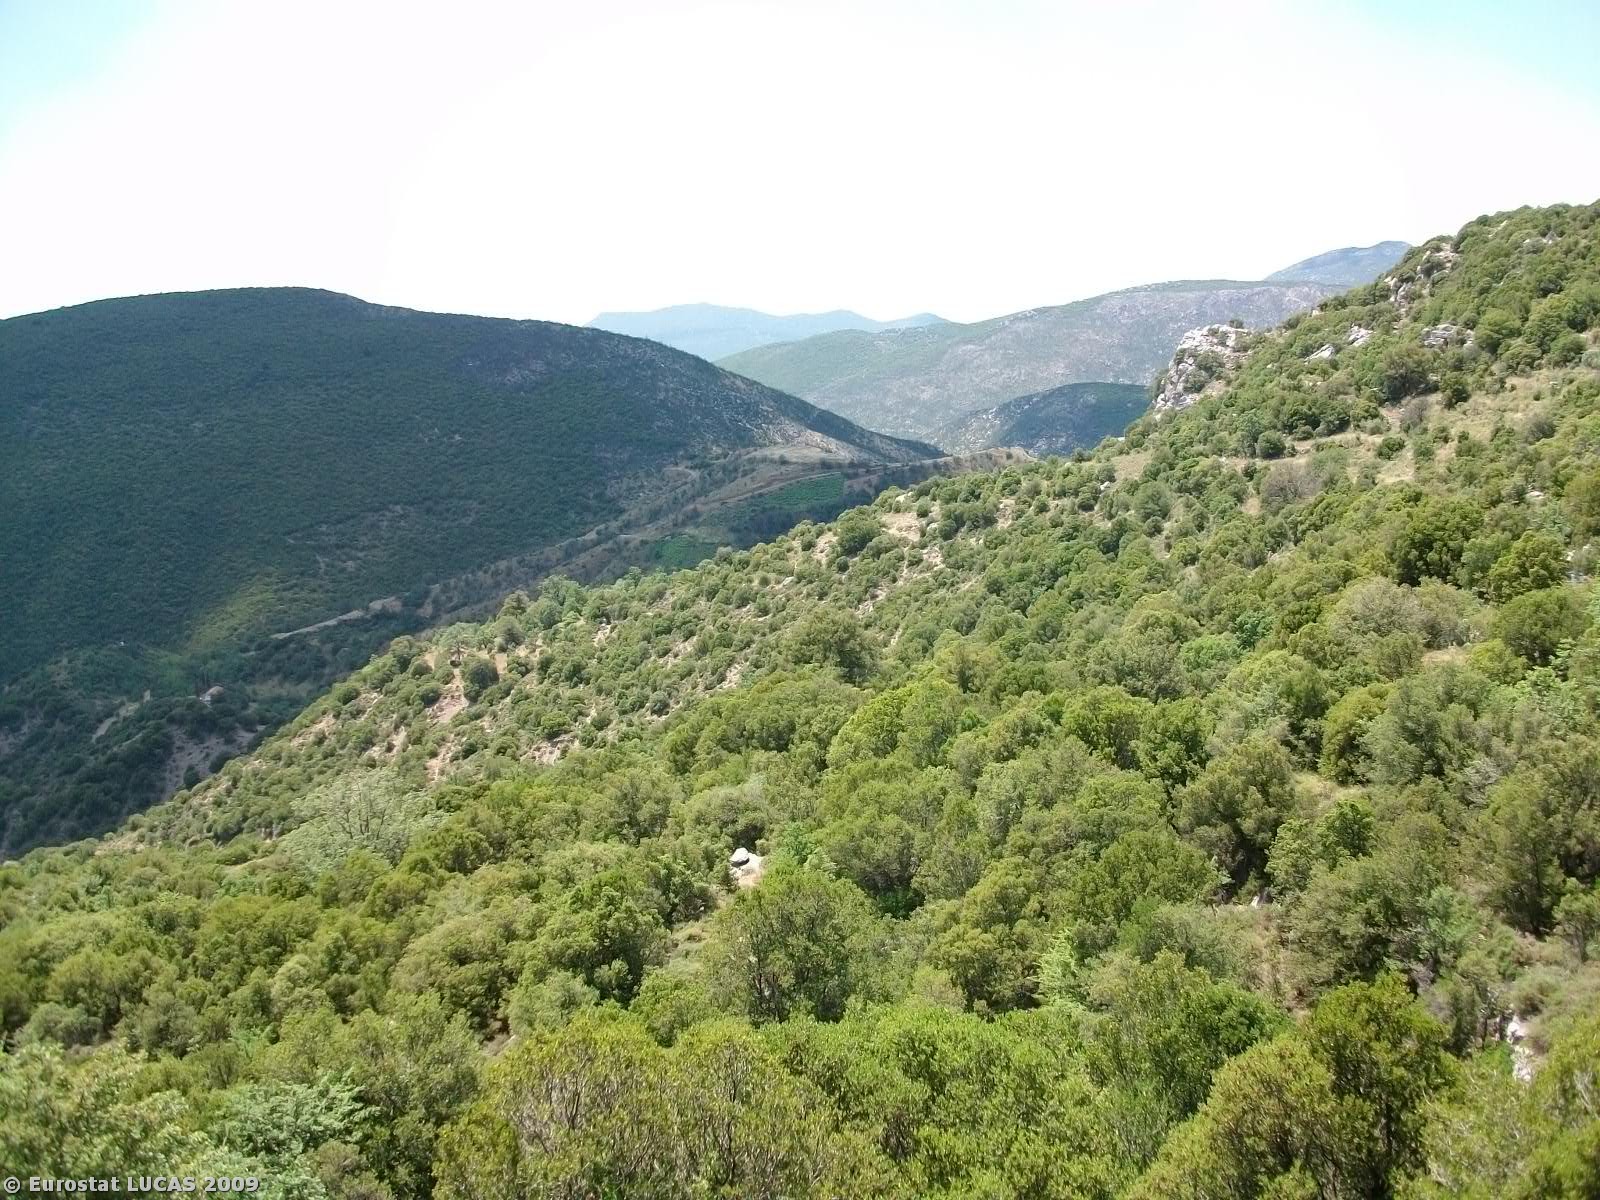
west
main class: Woodland
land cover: Broadleaved woodland
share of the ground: > 75 %
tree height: < 5 m
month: June
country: GR
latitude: 37.1817
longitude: 22.1773
